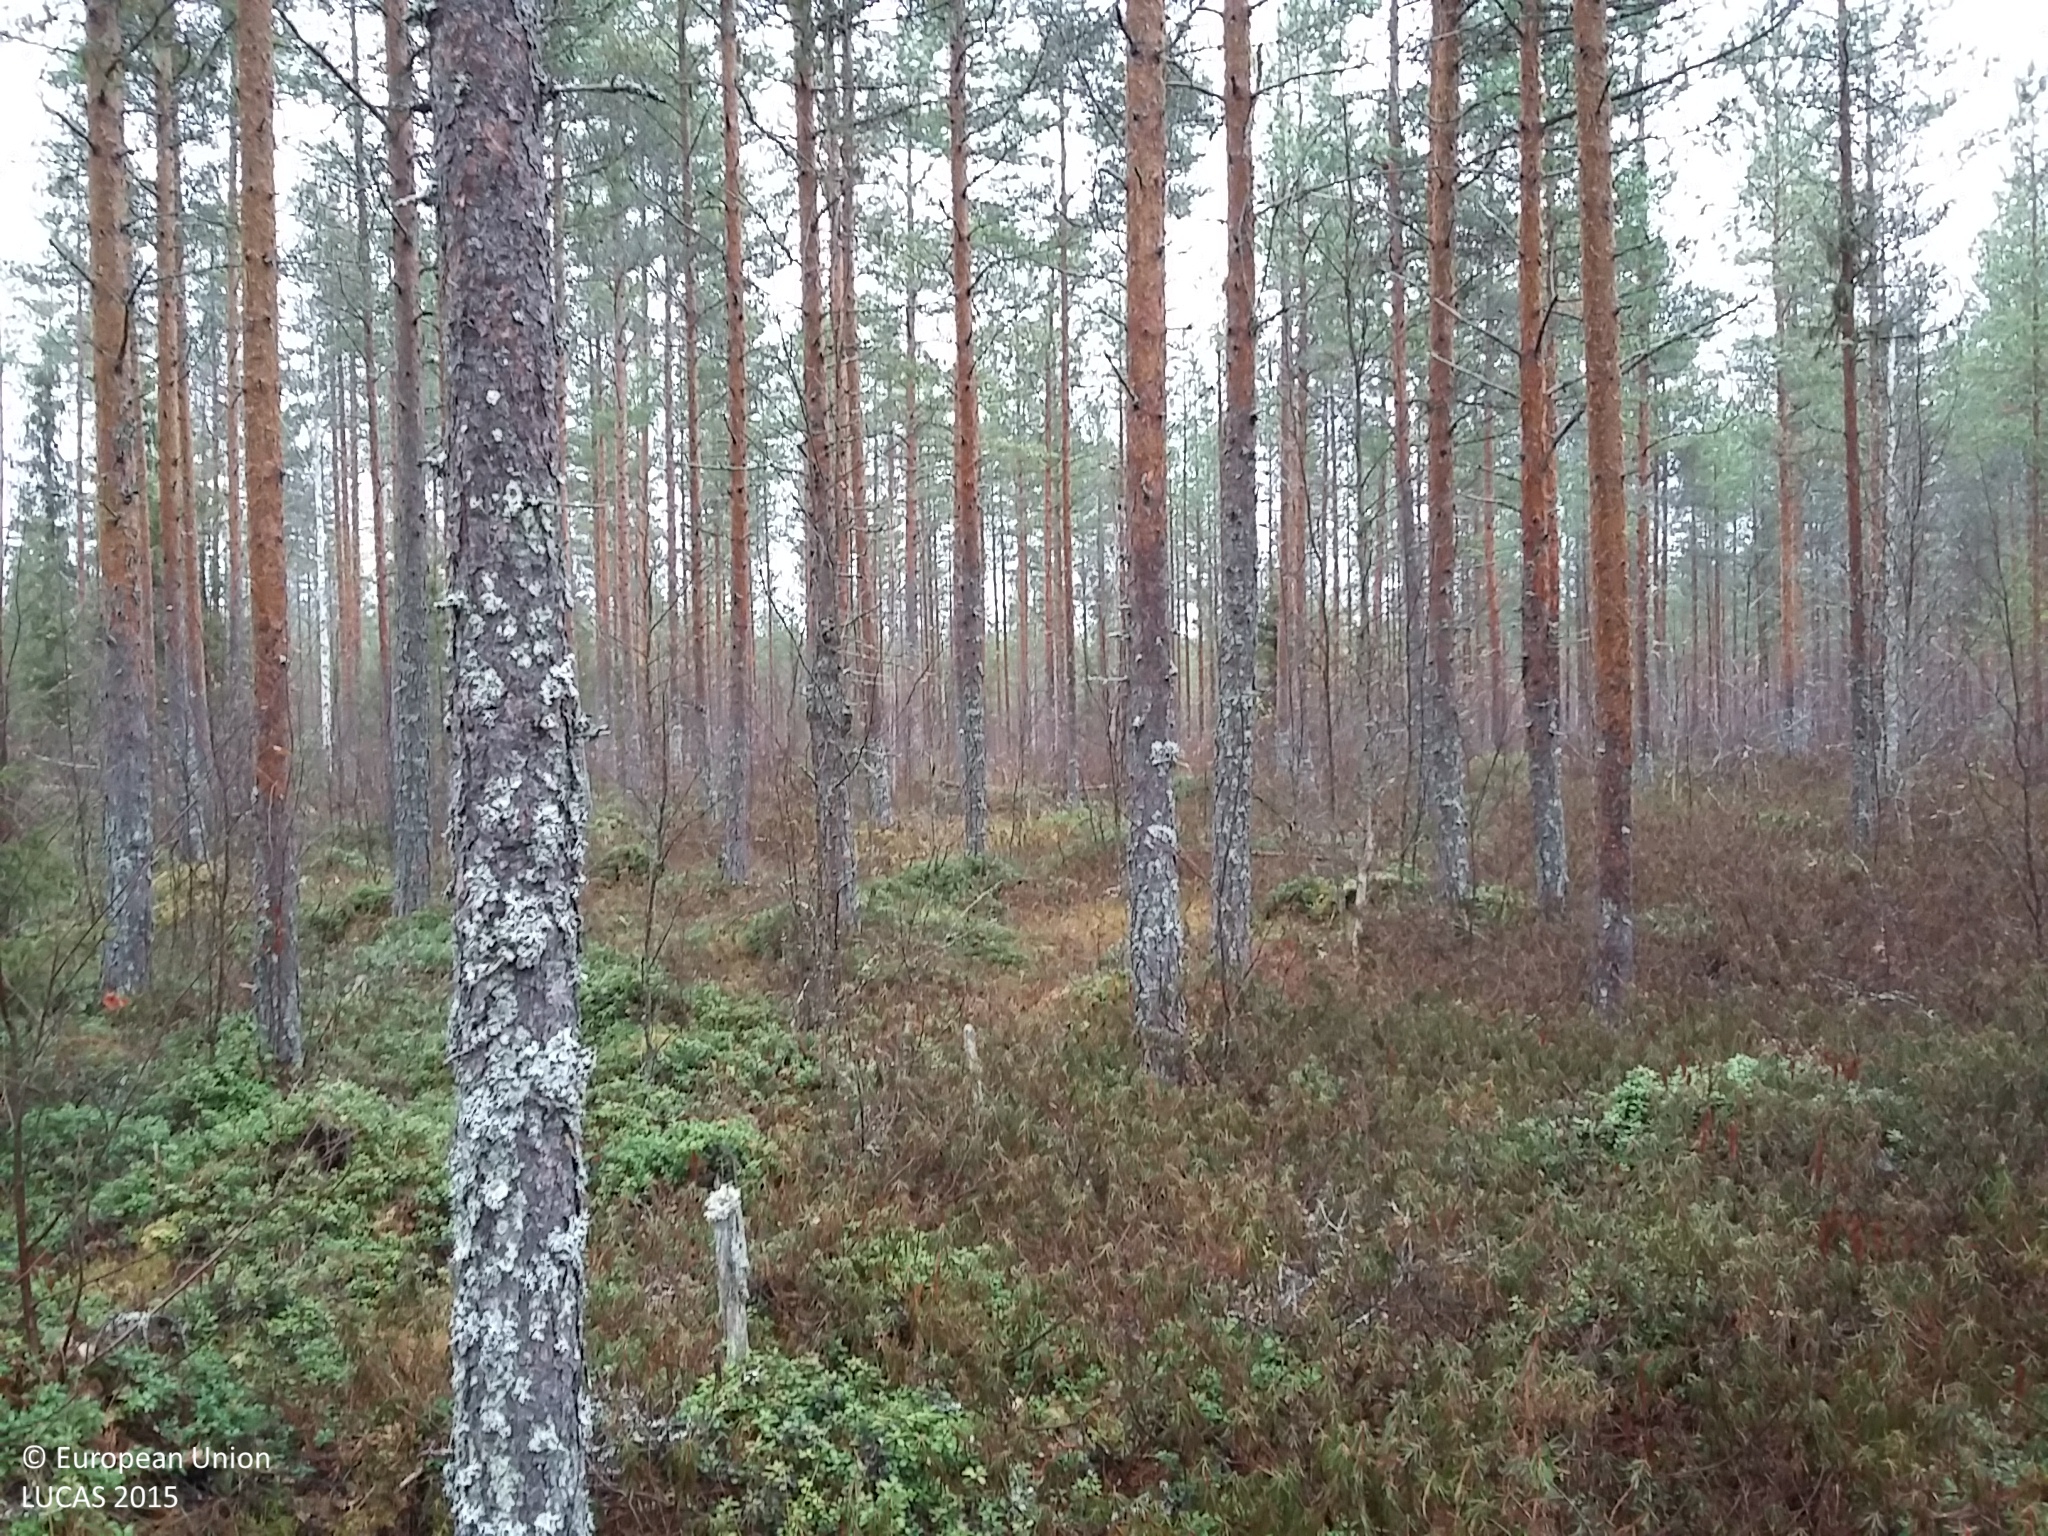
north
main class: Woodland
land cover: Pine dominated coniferous woodland
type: boreal forest
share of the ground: 50 - 75 %
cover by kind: coniferous forest trees 70 %, shrubs 20 %, lichens and mosses 10 %
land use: Forestry
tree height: > 5 m
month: October
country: FI
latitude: 64.3999
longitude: 25.3757
